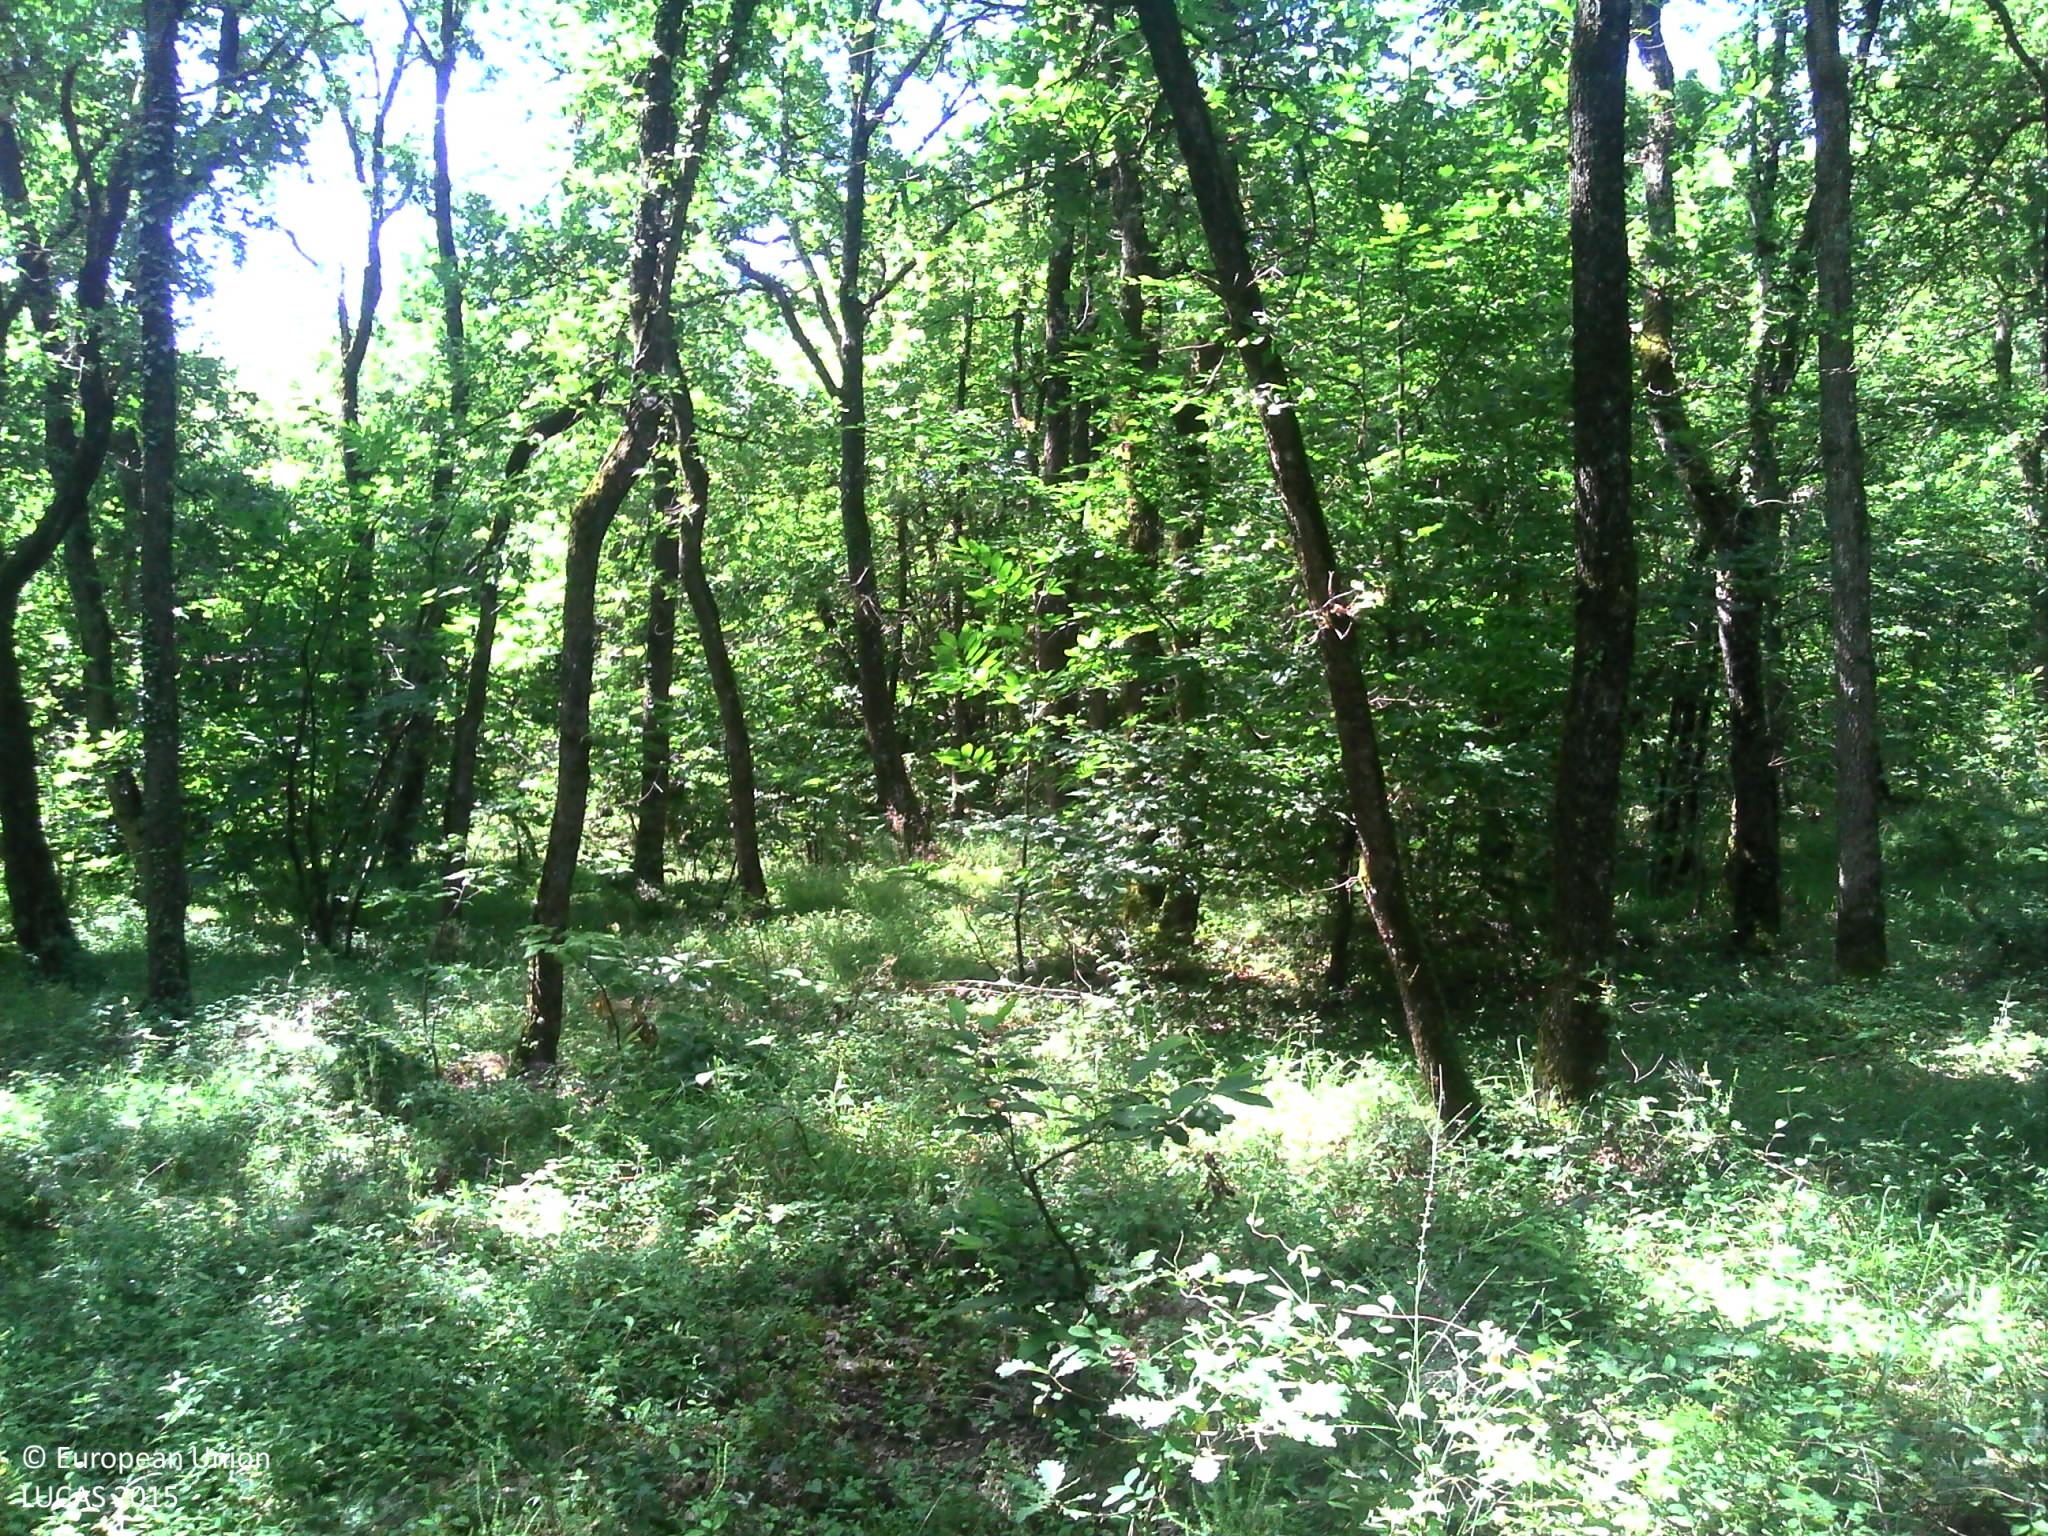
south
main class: Woodland
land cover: Broadleaved woodland
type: acidophilous oak and oak-birch forest
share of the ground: > 75 %
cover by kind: broadleaved forest trees 90 %, shrubs 5 %, herbaceous plants 5 %
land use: Forestry
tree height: > 5 m
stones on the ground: 10 - 25 %
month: June
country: FR
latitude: 46.7449
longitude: 0.5183
